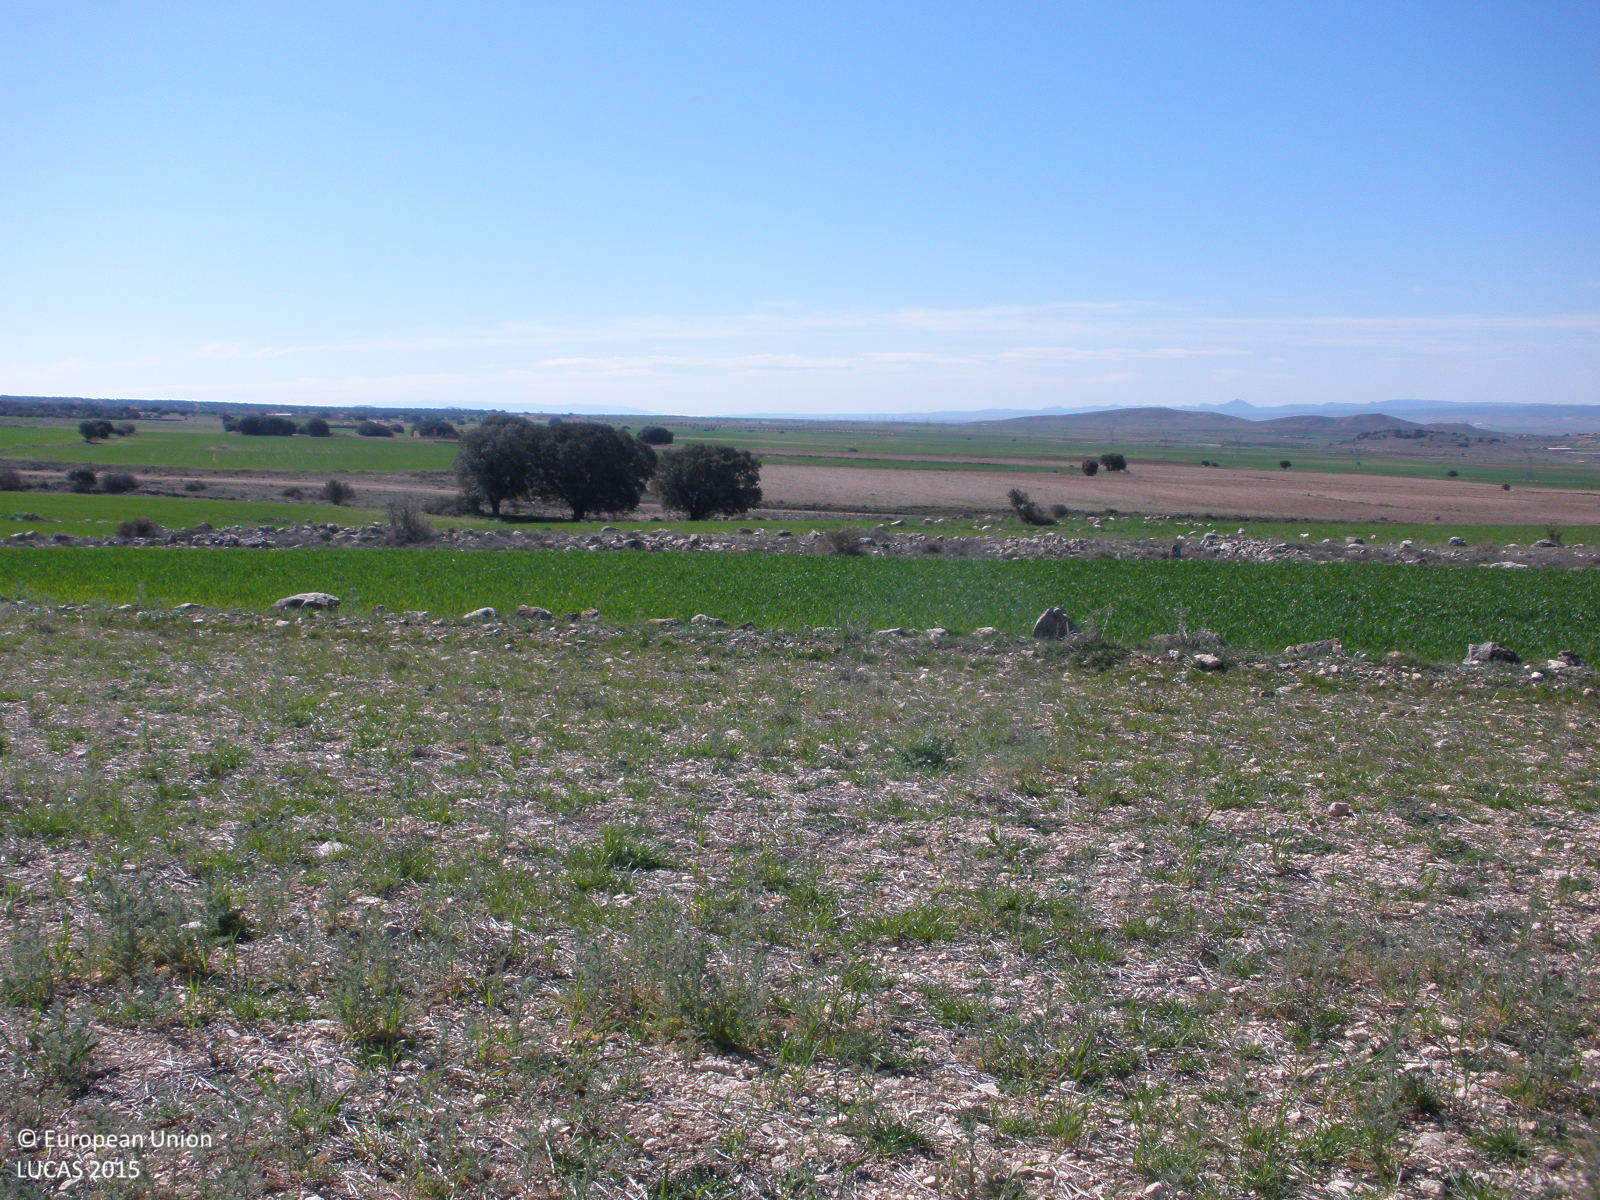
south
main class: Grassland
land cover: Spontaneously vegetated surfaces
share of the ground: 50 - 75 %
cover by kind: herbaceous plants 75 %, unconsolidated bare surface 25 %
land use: Agriculture (excluding fallow land and kitchen gardens)
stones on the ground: 25 - 50 %
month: April
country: ES
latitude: 40.6897
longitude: -1.2926
